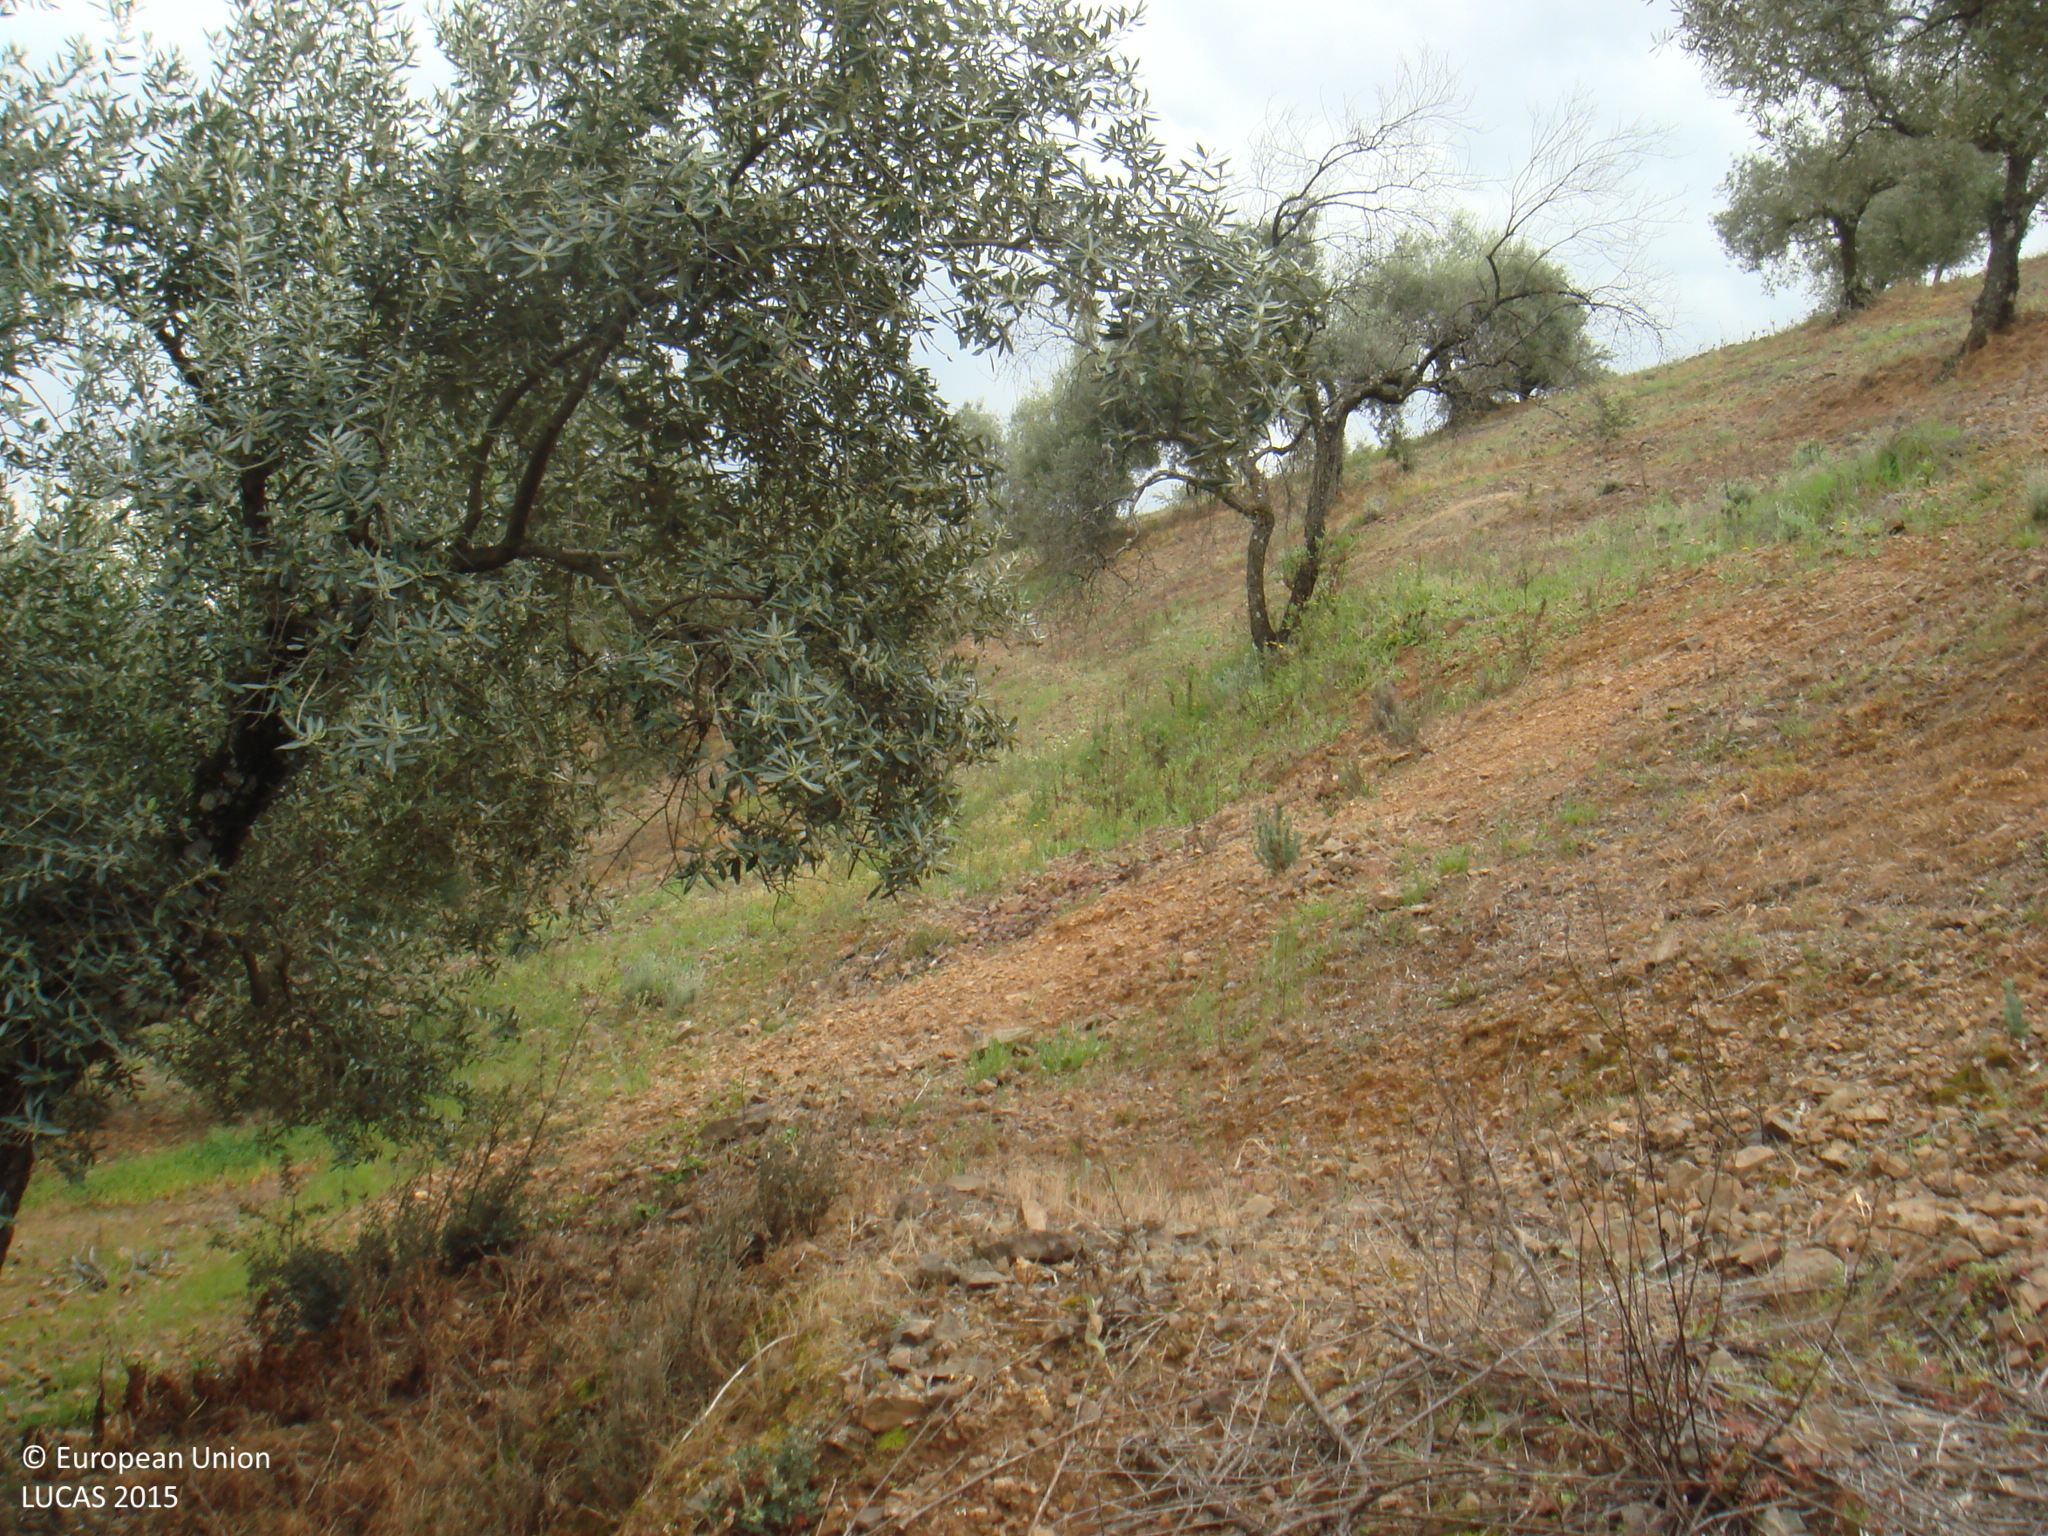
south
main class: Cropland
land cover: Olive groves
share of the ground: 10 - 25 %
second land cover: Spontaneously vegetated surfaces
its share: 50 - 75 %
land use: Agriculture (excluding fallow land and kitchen gardens)
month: April
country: ES
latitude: 38.0580
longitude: -5.0075
